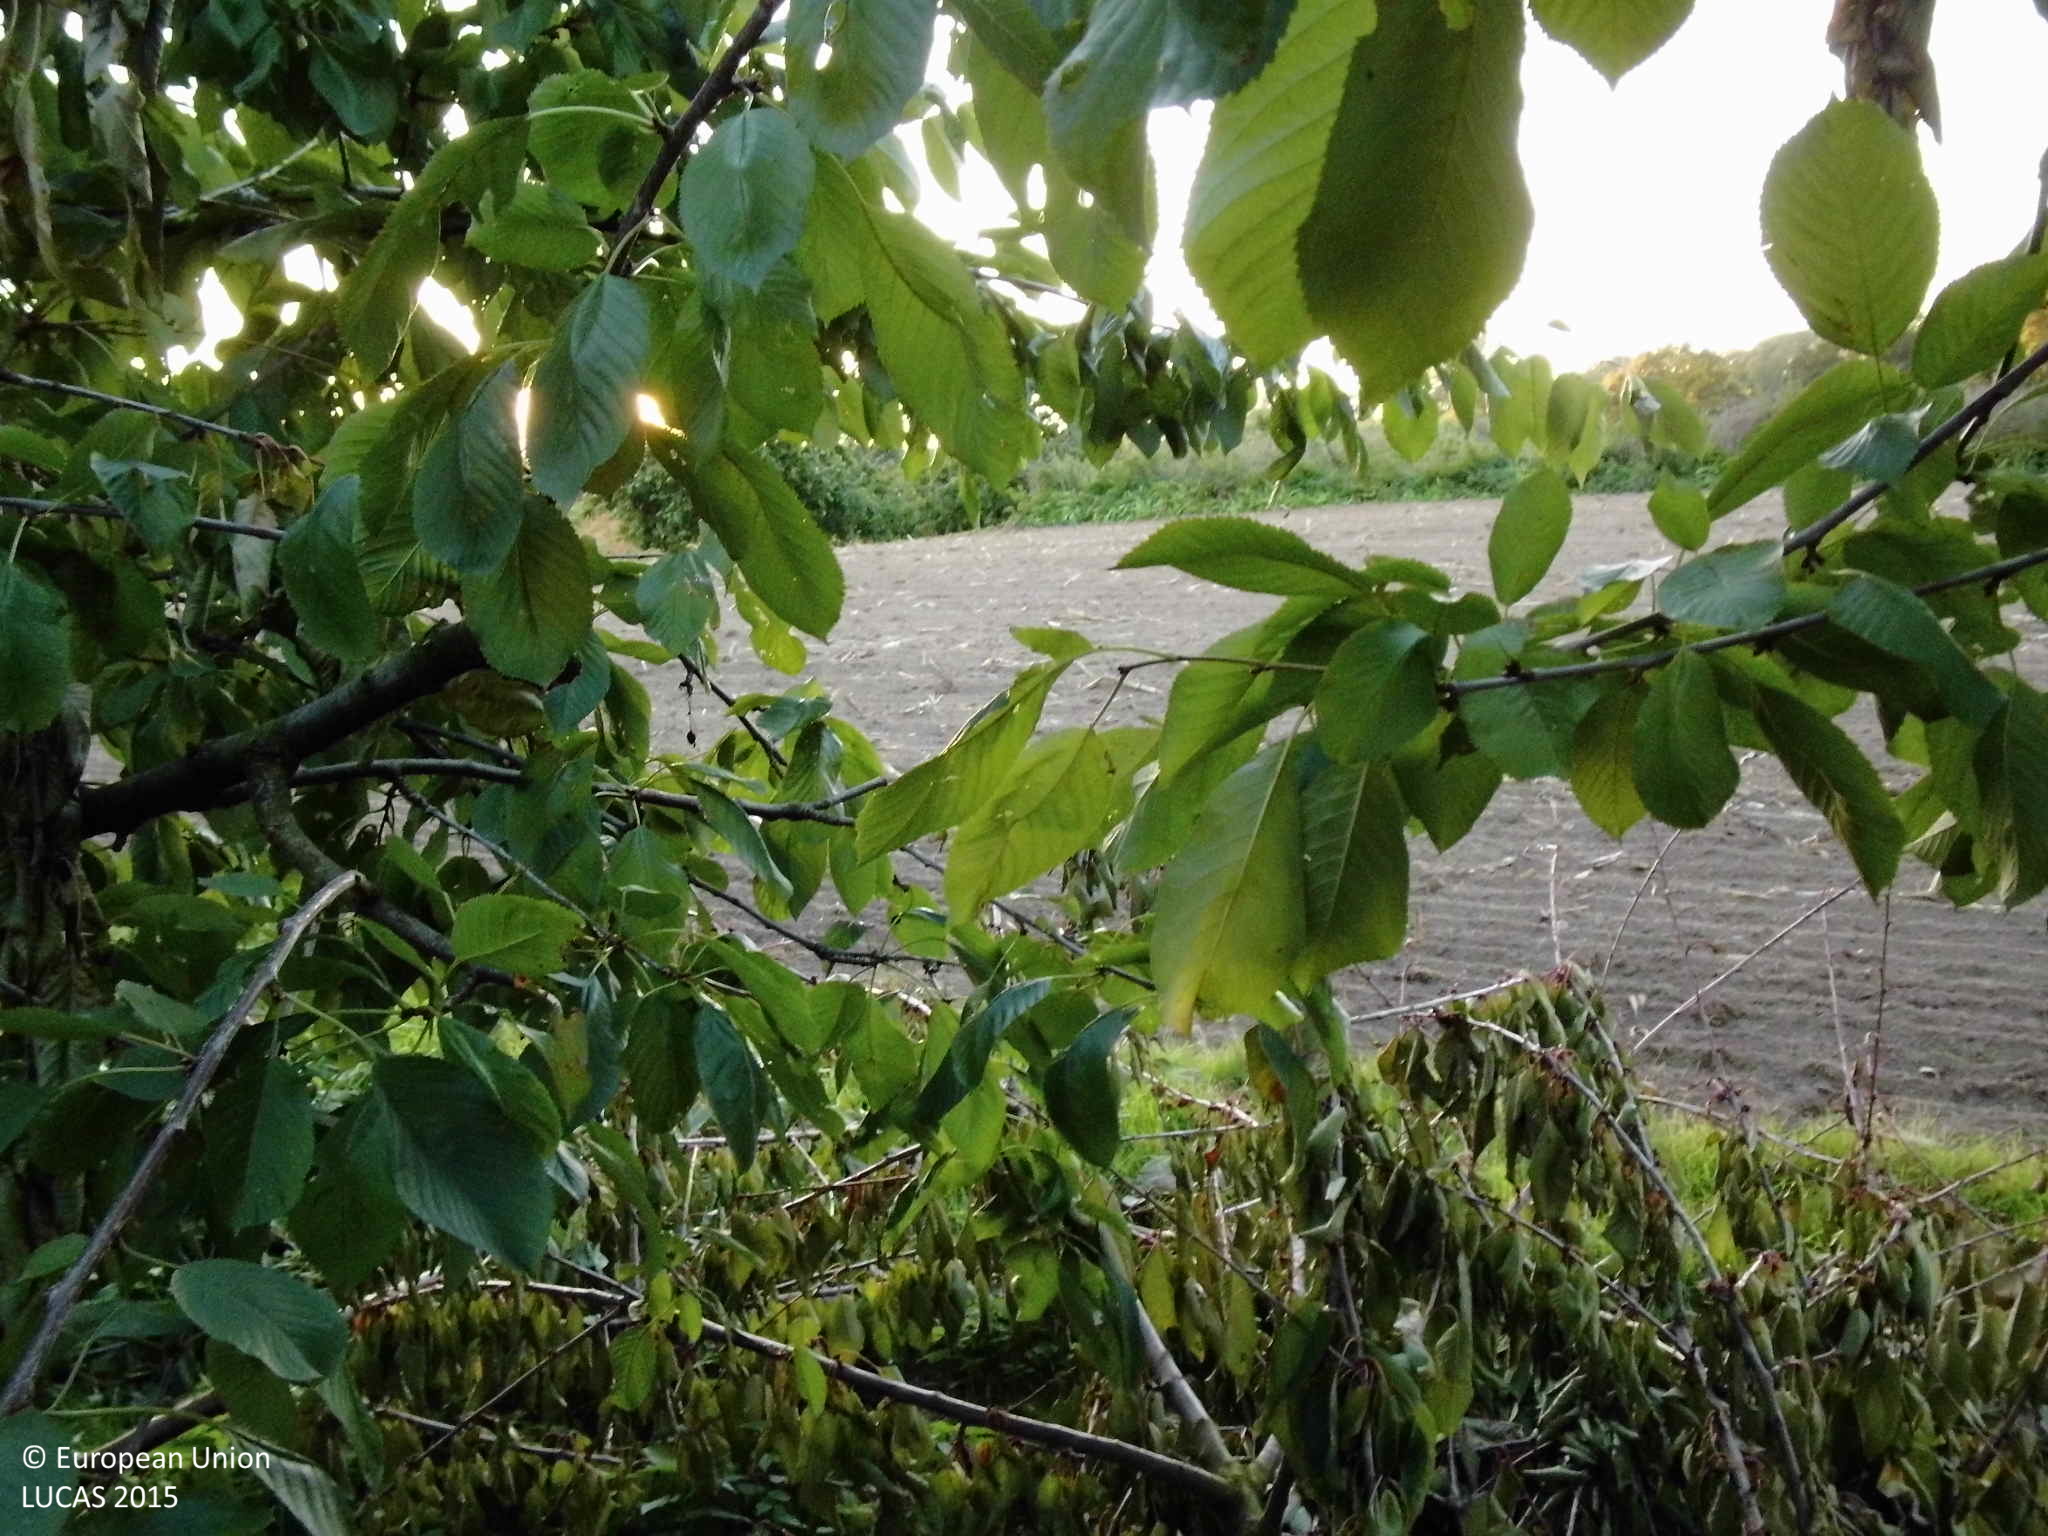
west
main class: Cropland
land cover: Cherry fruit
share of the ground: > 75 %
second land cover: Grassland without tree/shrub cover
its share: > 75 %
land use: Agriculture (excluding fallow land and kitchen gardens)
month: September
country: DE
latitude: 50.3897
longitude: 7.4544
